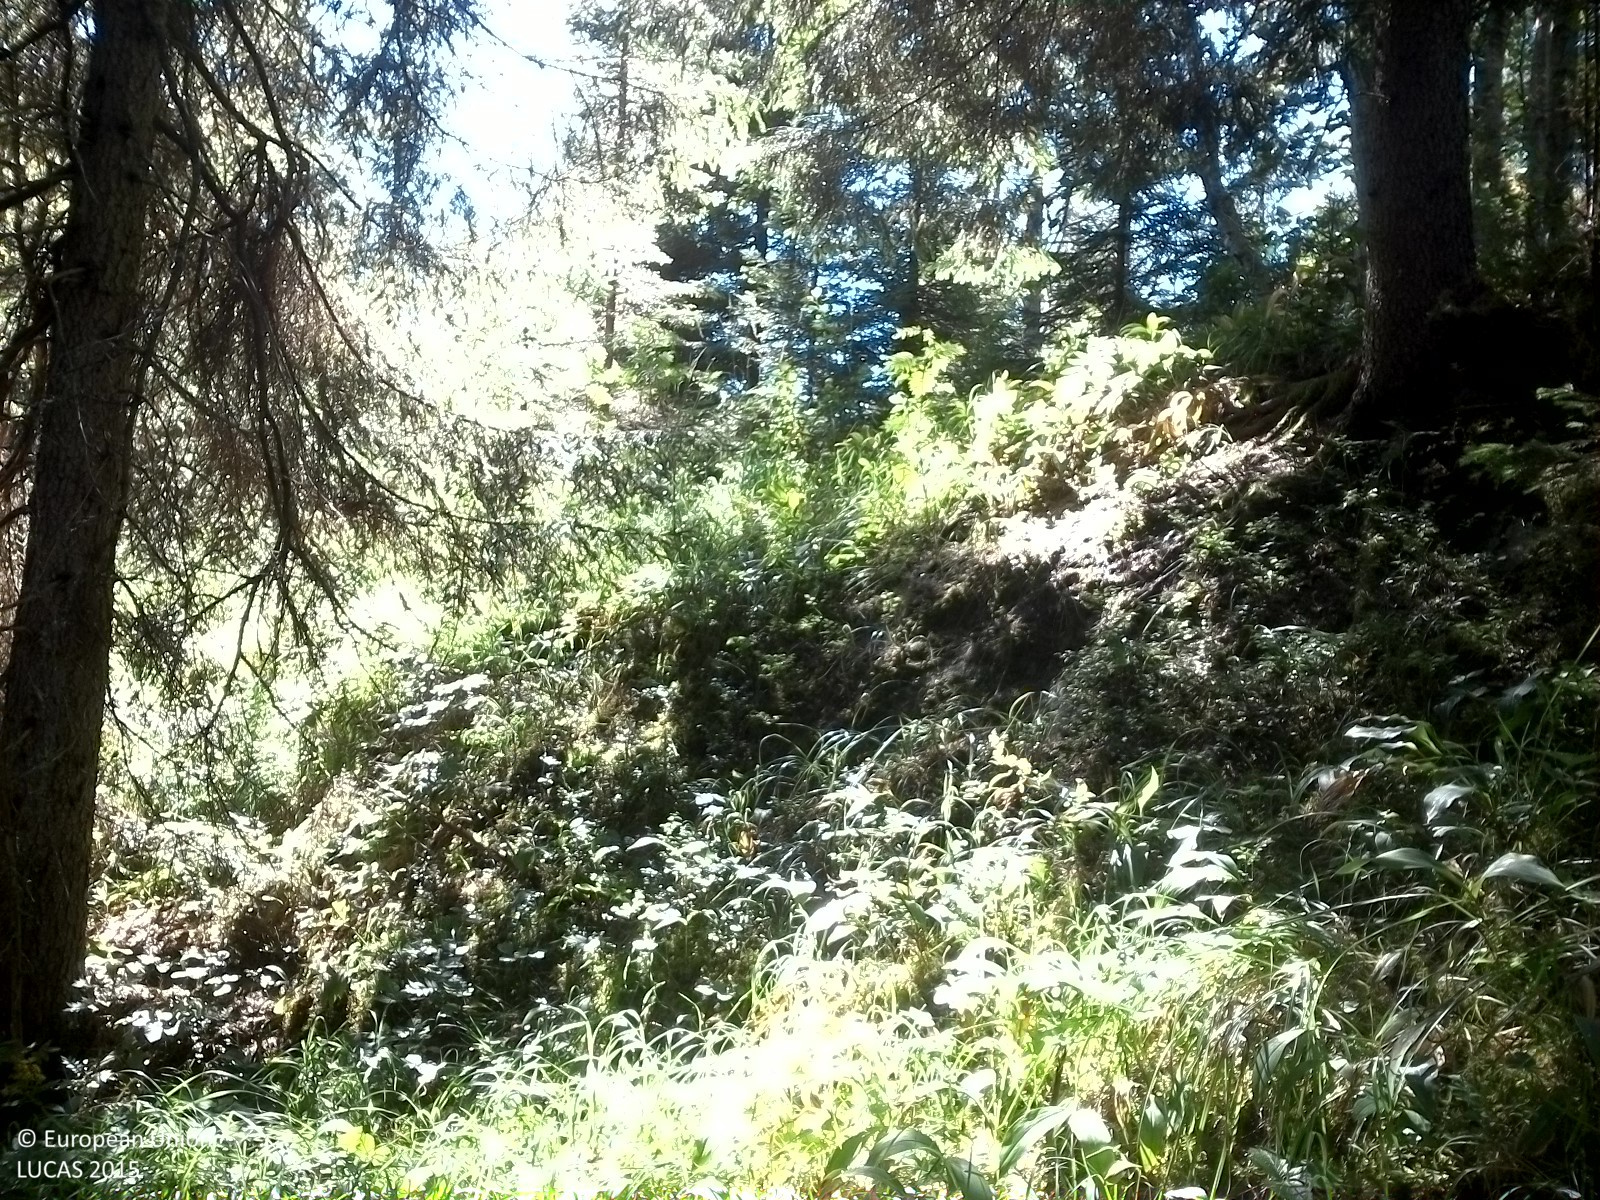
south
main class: Woodland
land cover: Spruce dominated coniferous woodland
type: boreal forest
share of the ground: 50 - 75 %
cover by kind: coniferous forest trees 60 %, herbaceous plants 20 %, lichens and mosses 20 %
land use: Forestry
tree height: > 5 m
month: August
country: SE
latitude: 59.4149
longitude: 14.7661
